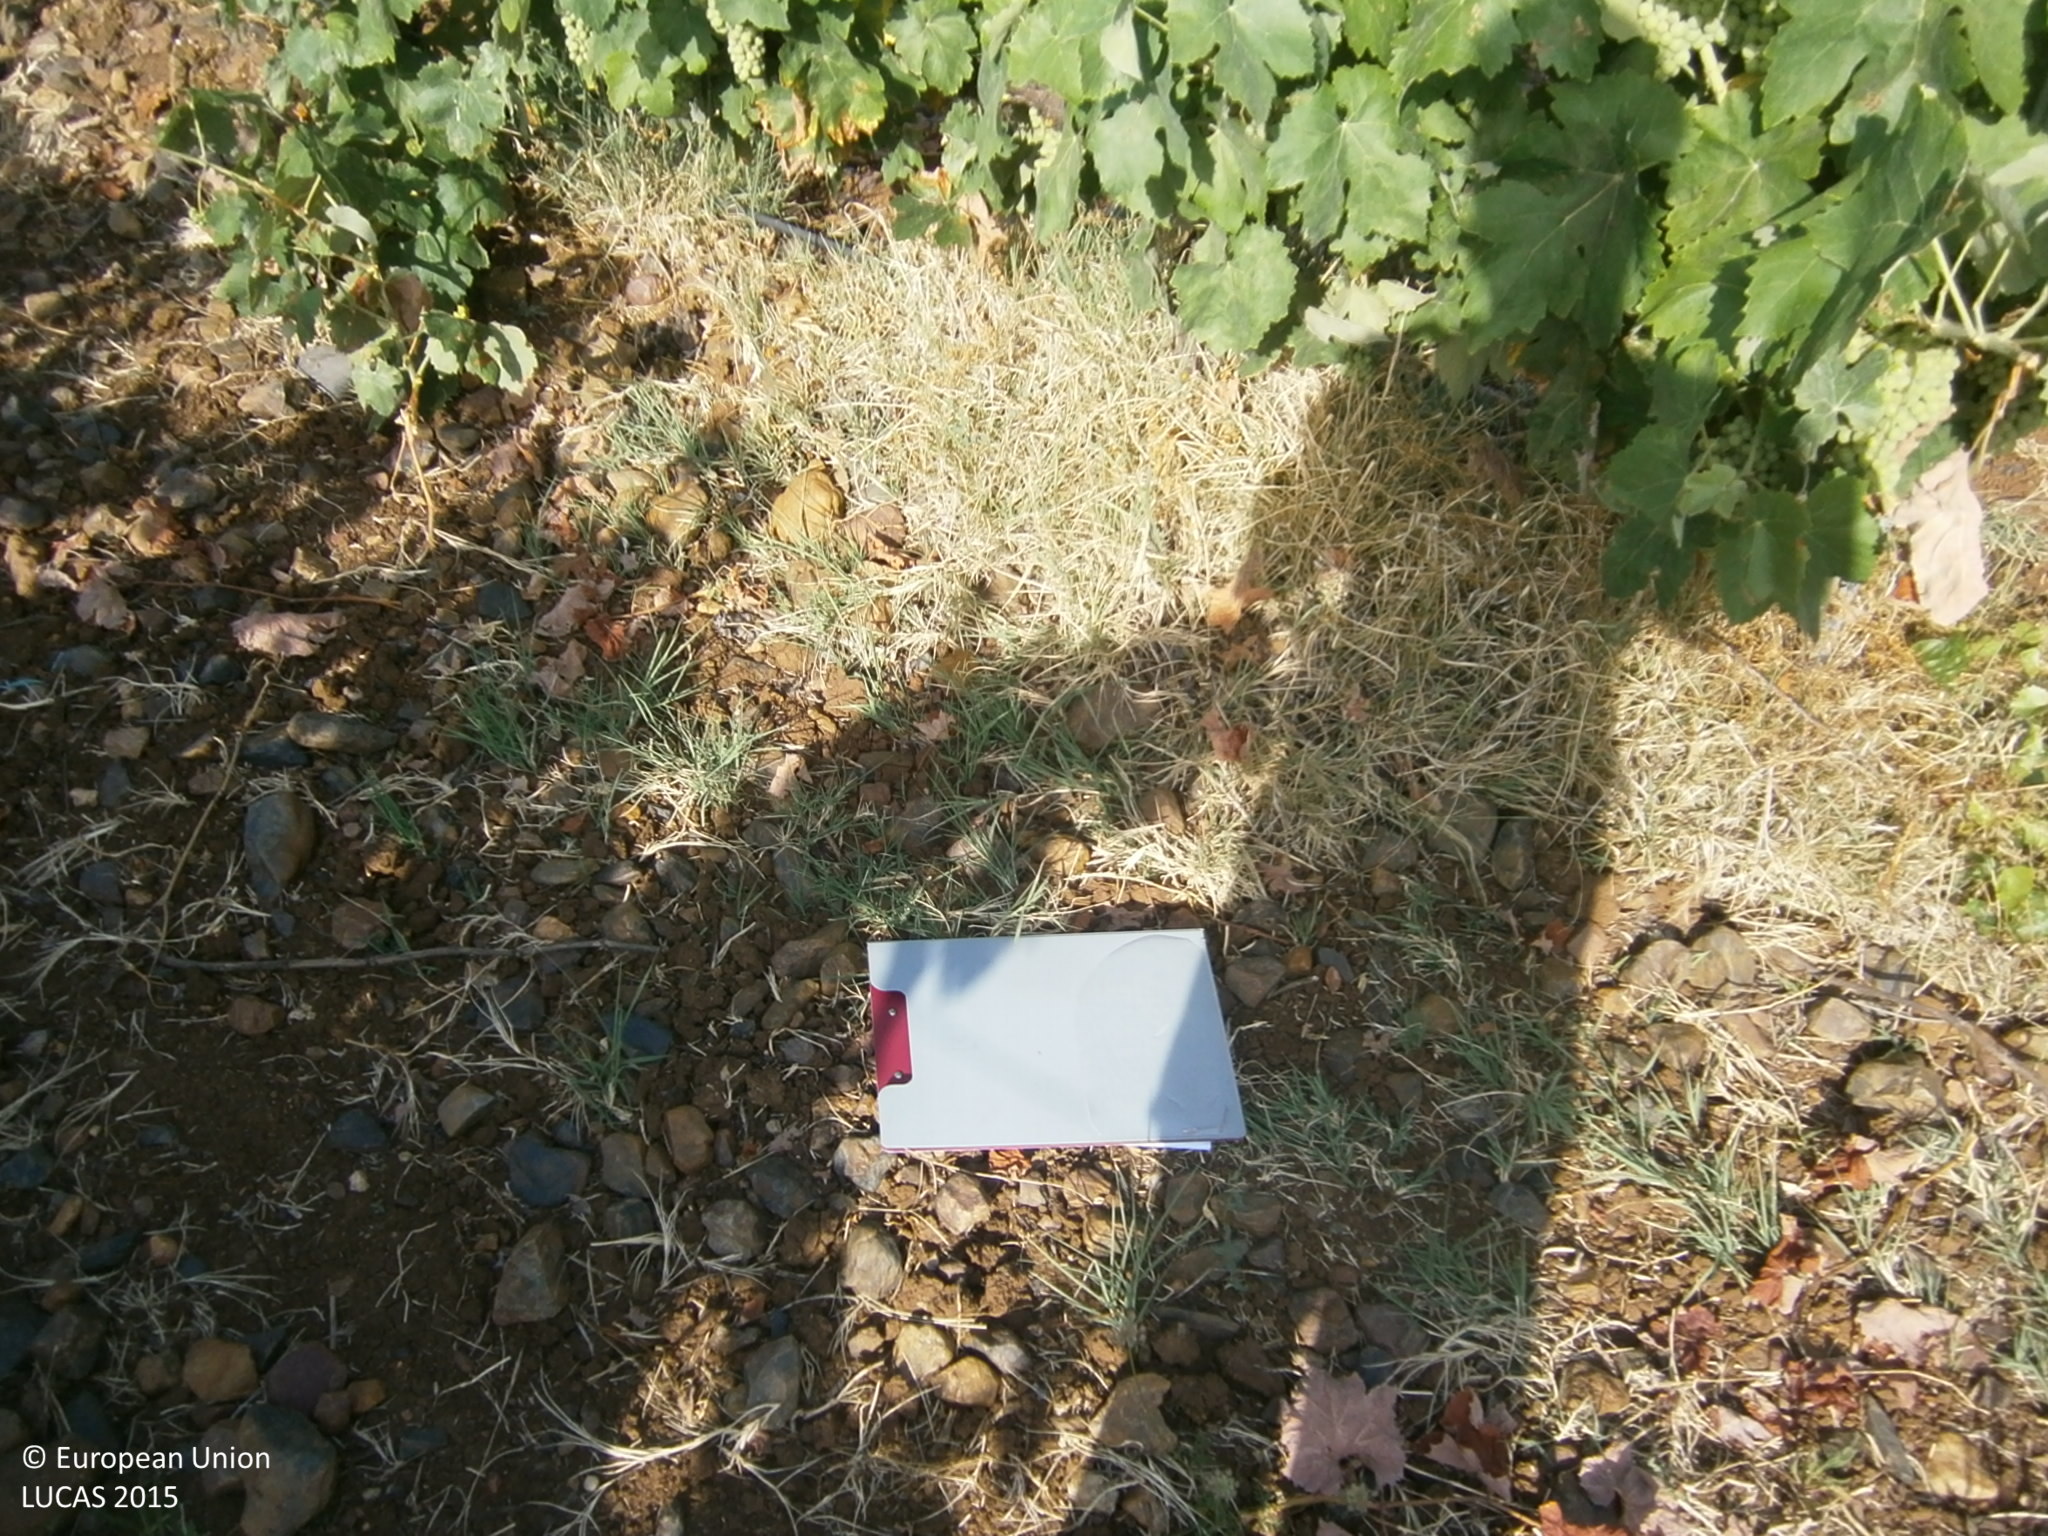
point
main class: Cropland
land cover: Vineyards
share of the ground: 25 - 50 %
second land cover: Spontaneously vegetated surfaces
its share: 25 - 50 %
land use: Agriculture (excluding fallow land and kitchen gardens)
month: June
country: ES
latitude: 38.7153
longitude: -6.7967
